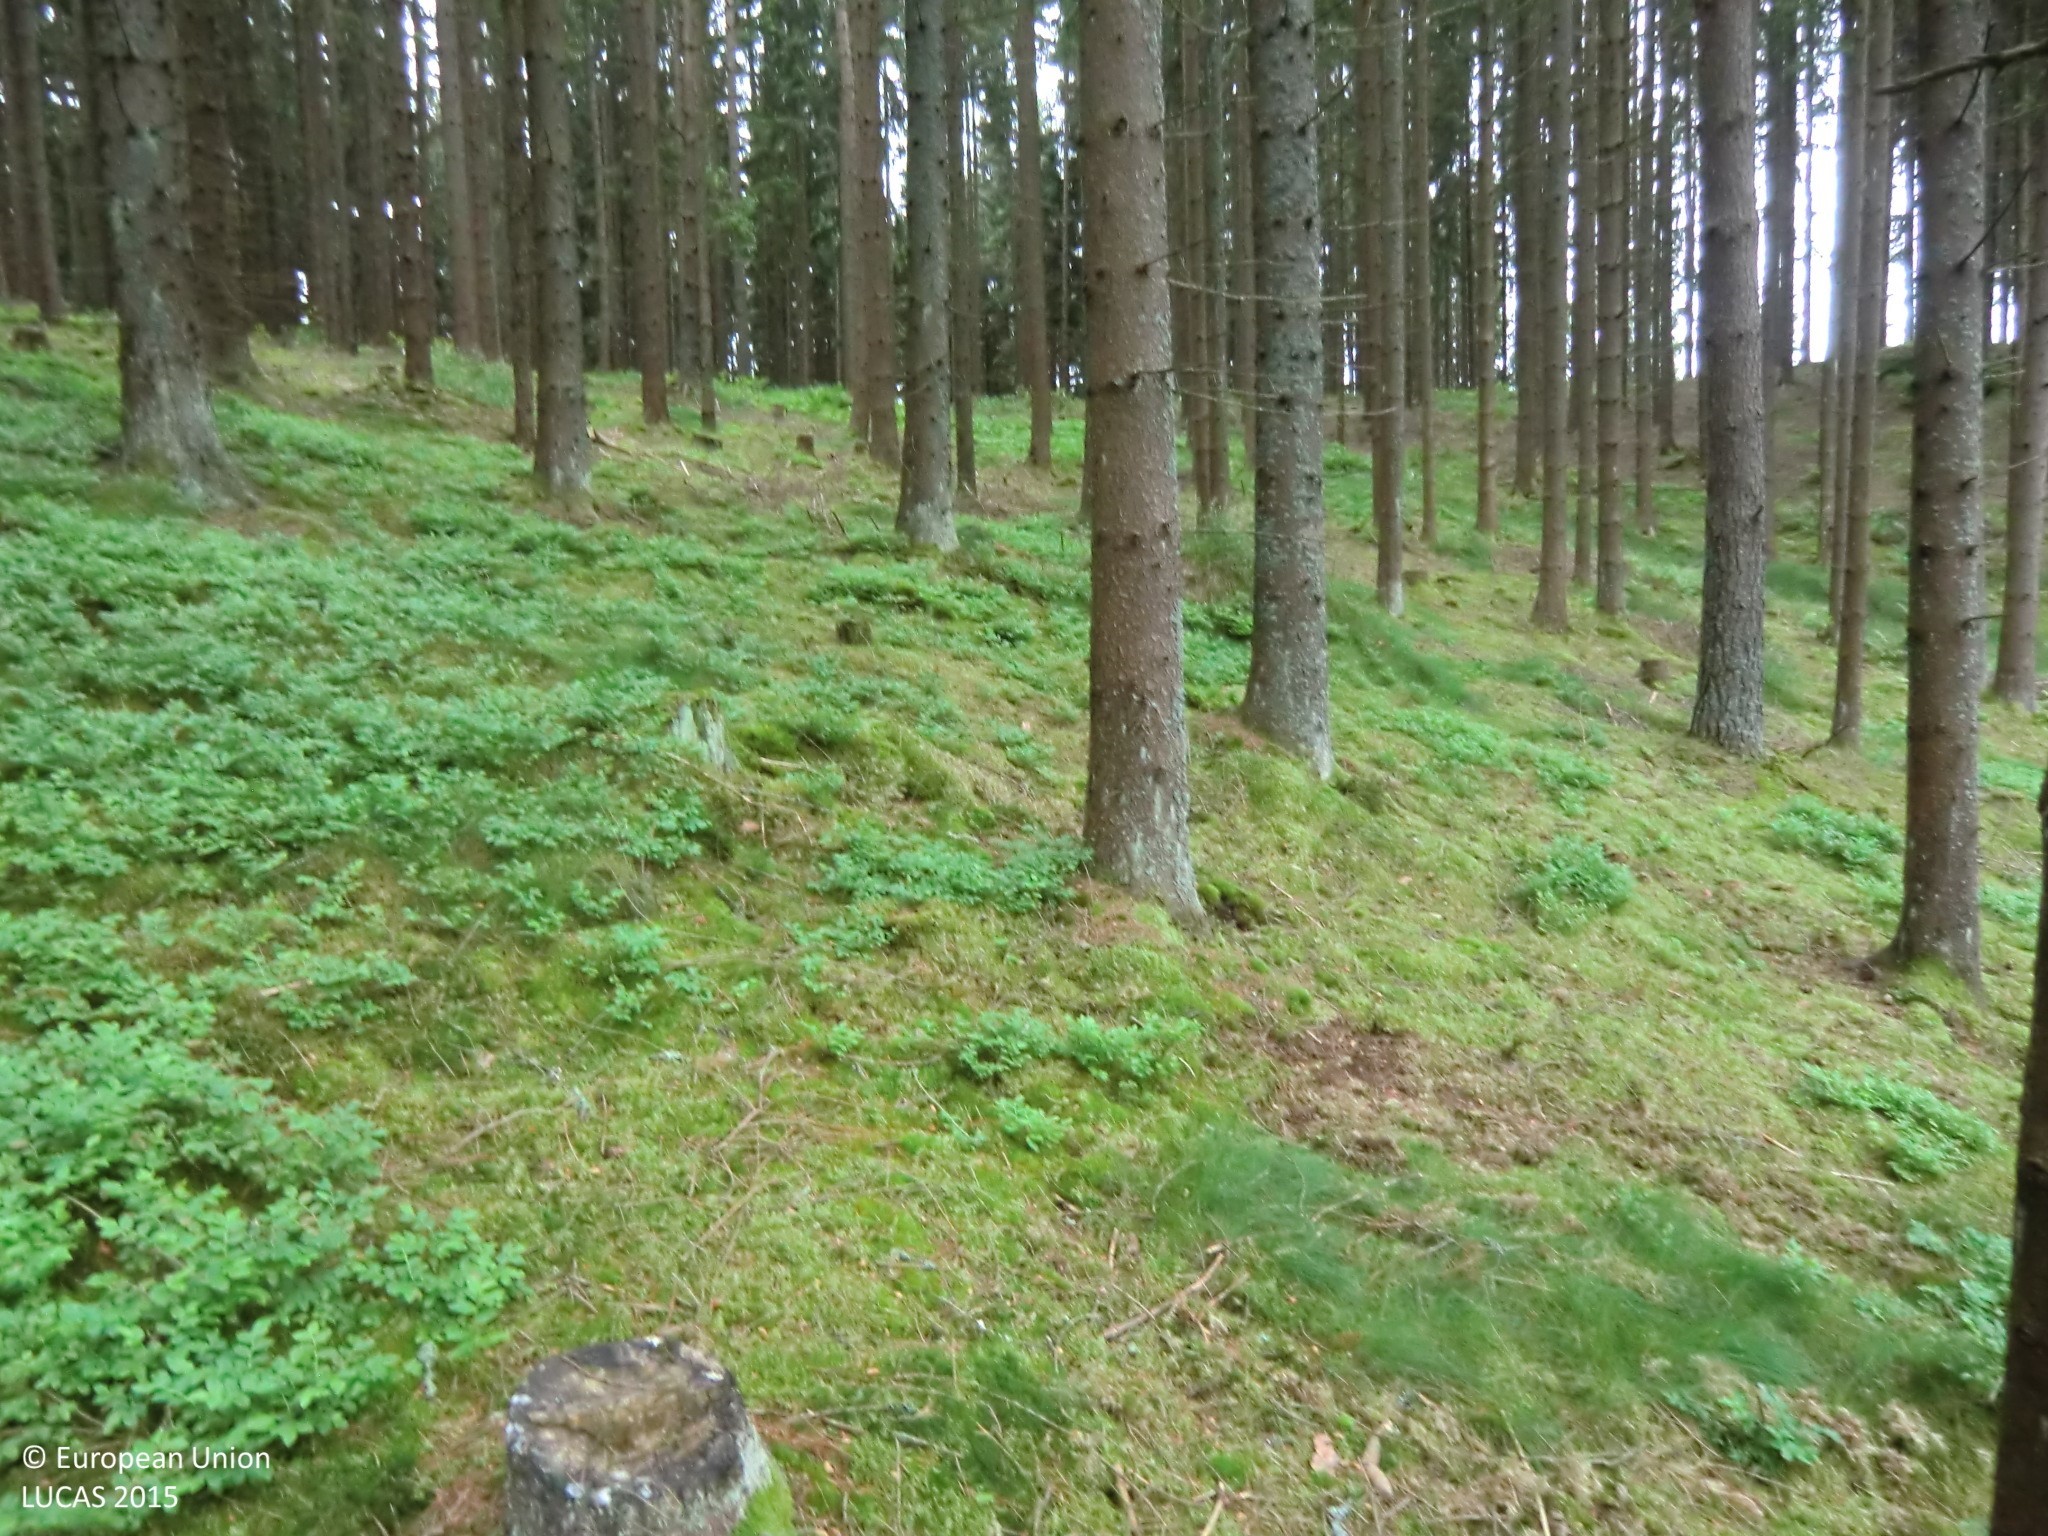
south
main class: Woodland
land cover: Spruce dominated coniferous woodland
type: hemiboreal forest and nemoral coniferous forest and mixed broadleaved-coniferous forest
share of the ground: > 75 %
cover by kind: coniferous forest trees 75 %, unconsolidated bare surface 15 %, shrubs 5 %, herbaceous plants 5 %
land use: Forestry
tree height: > 5 m
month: May
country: AT
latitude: 48.4052
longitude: 14.8507
